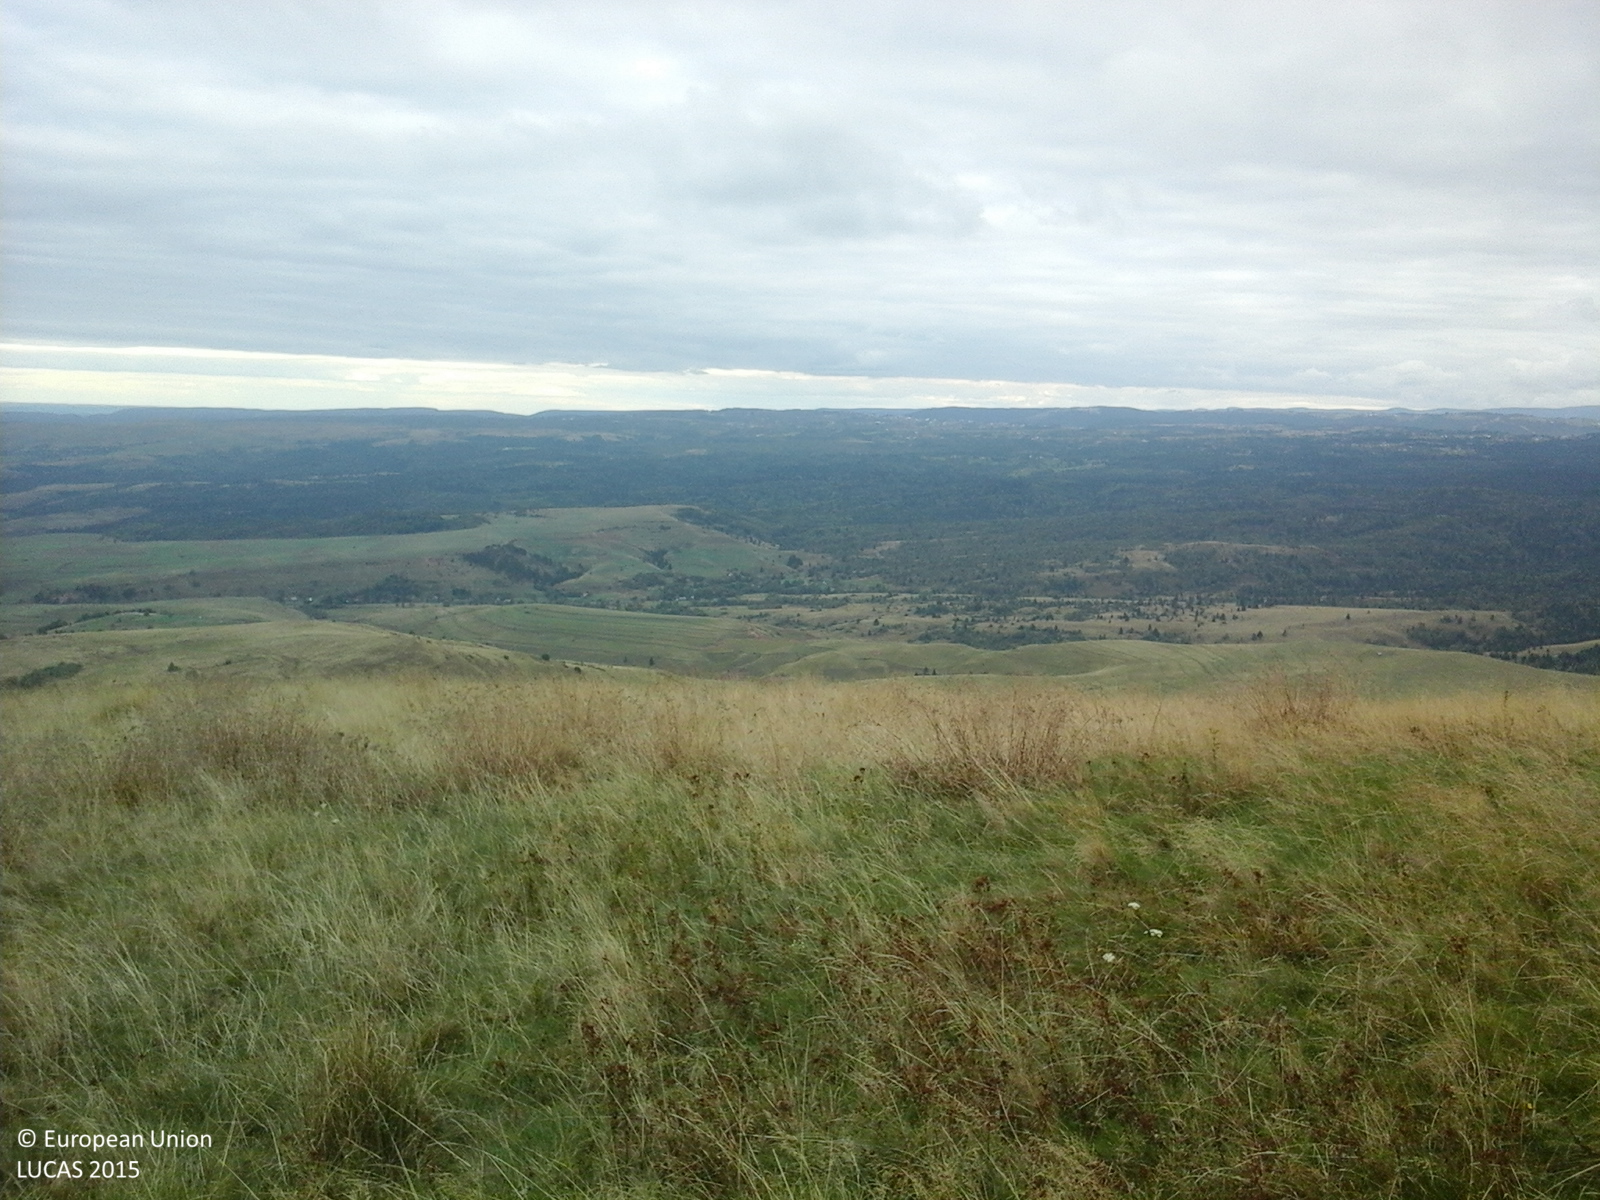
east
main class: Grassland
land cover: Spontaneously vegetated surfaces
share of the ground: > 75 %
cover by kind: herbaceous plants 100 %
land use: Agriculture (excluding fallow land and kitchen gardens)
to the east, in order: Spontaneously vegetated surfaces
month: September
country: RO
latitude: 46.7302
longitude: 22.9224
